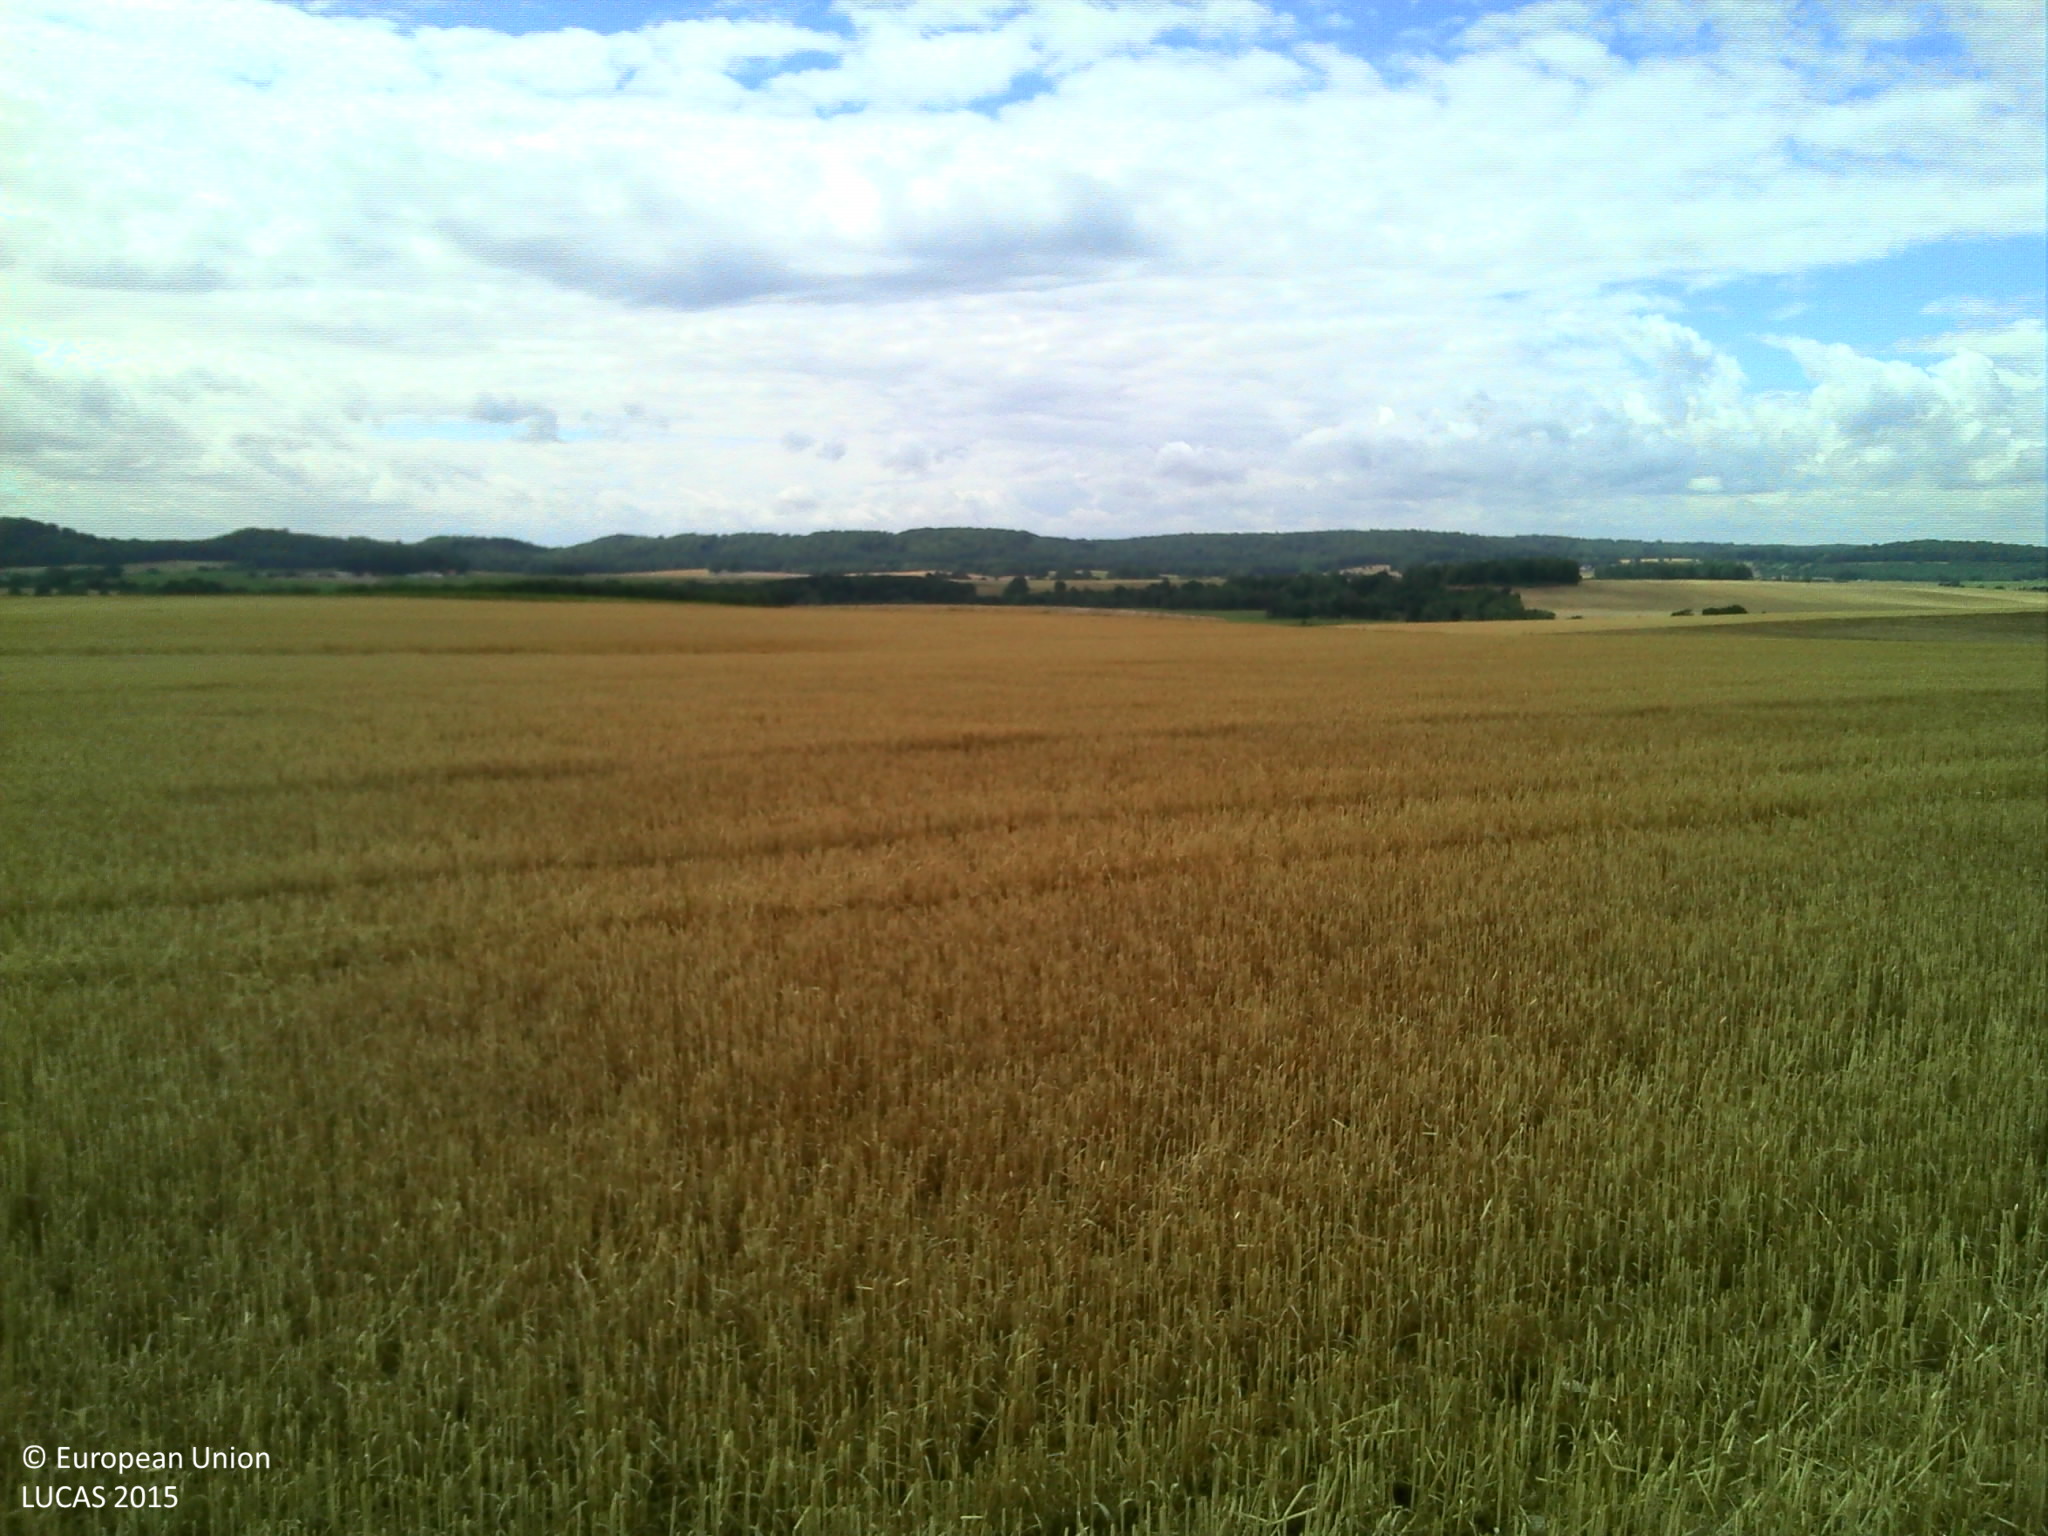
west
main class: Cropland
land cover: Common wheat
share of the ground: > 75 %
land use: Agriculture (excluding fallow land and kitchen gardens)
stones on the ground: < 10 %
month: July
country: FR
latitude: 49.1243
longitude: 5.1060
